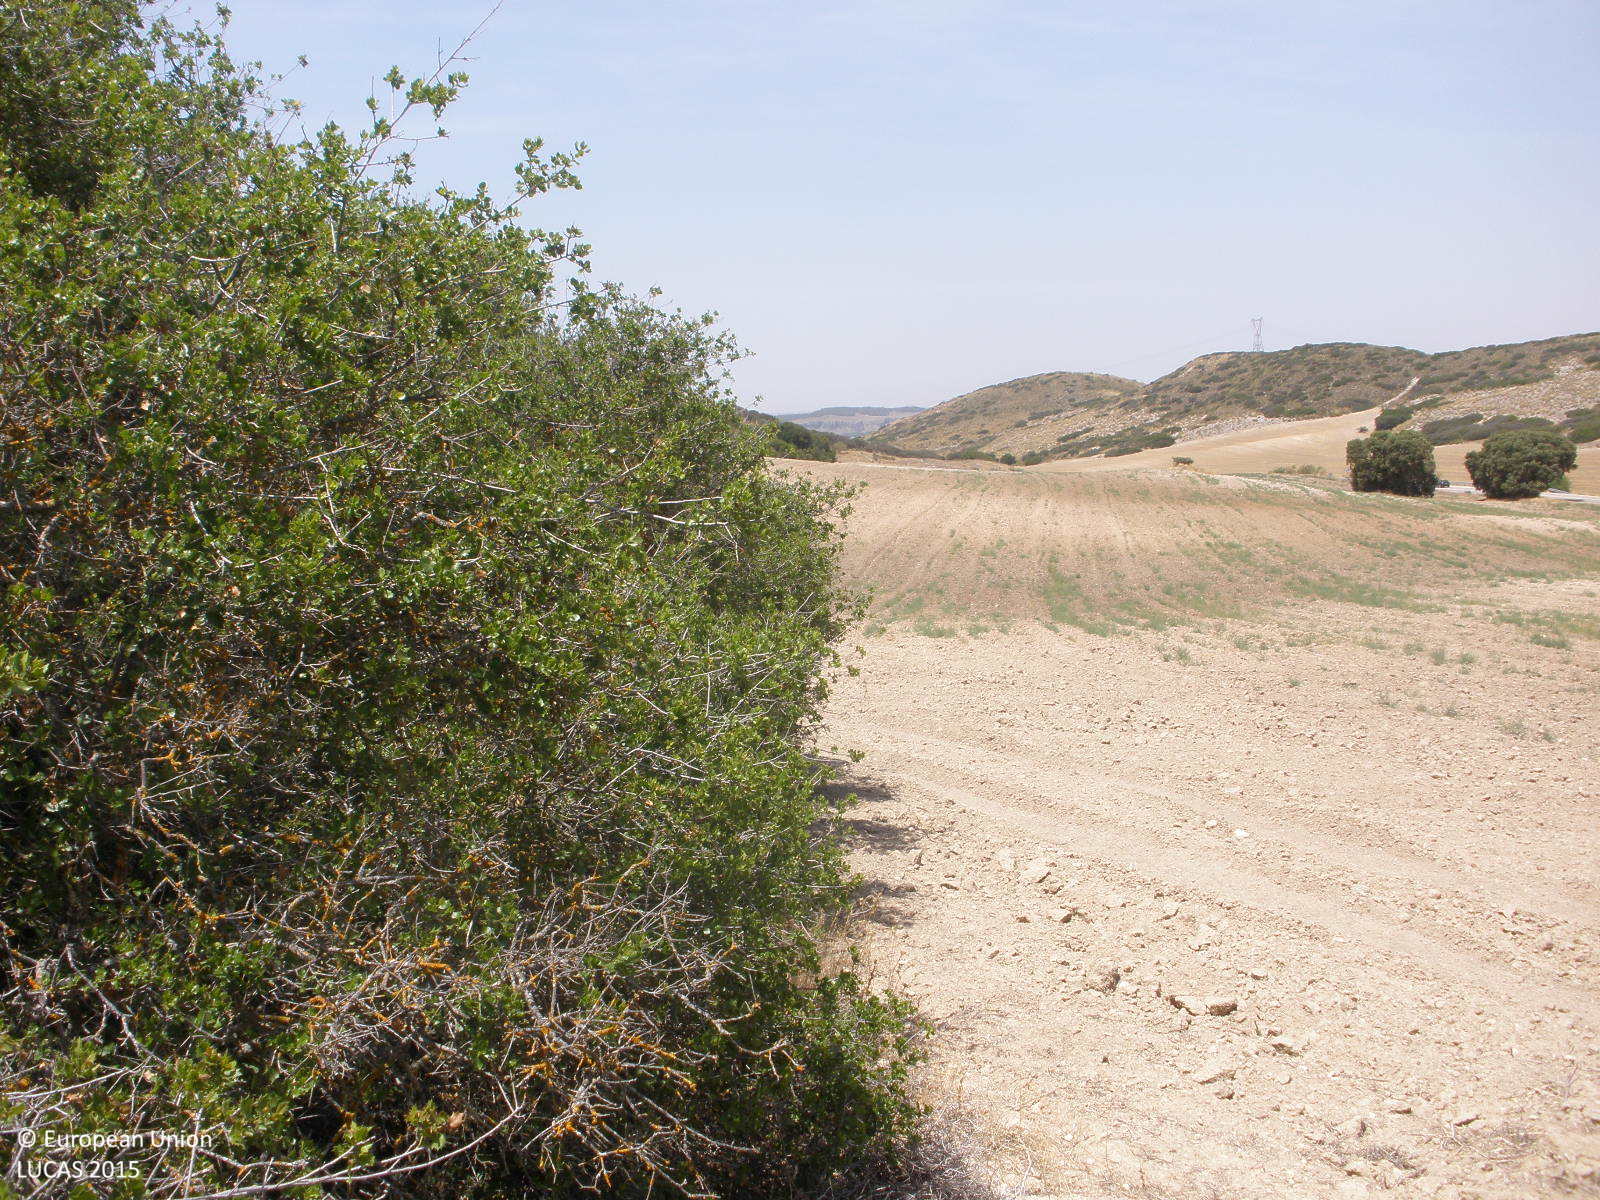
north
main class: Woodland
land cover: Broadleaved woodland
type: broadleaved evergreen forest
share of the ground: > 75 %
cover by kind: broadleaved forest trees 80 %, shrubs 20 %
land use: Semi-natural and natural areas not in use
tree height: < 5 m
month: July
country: ES
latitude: 40.2640
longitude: -3.4965
